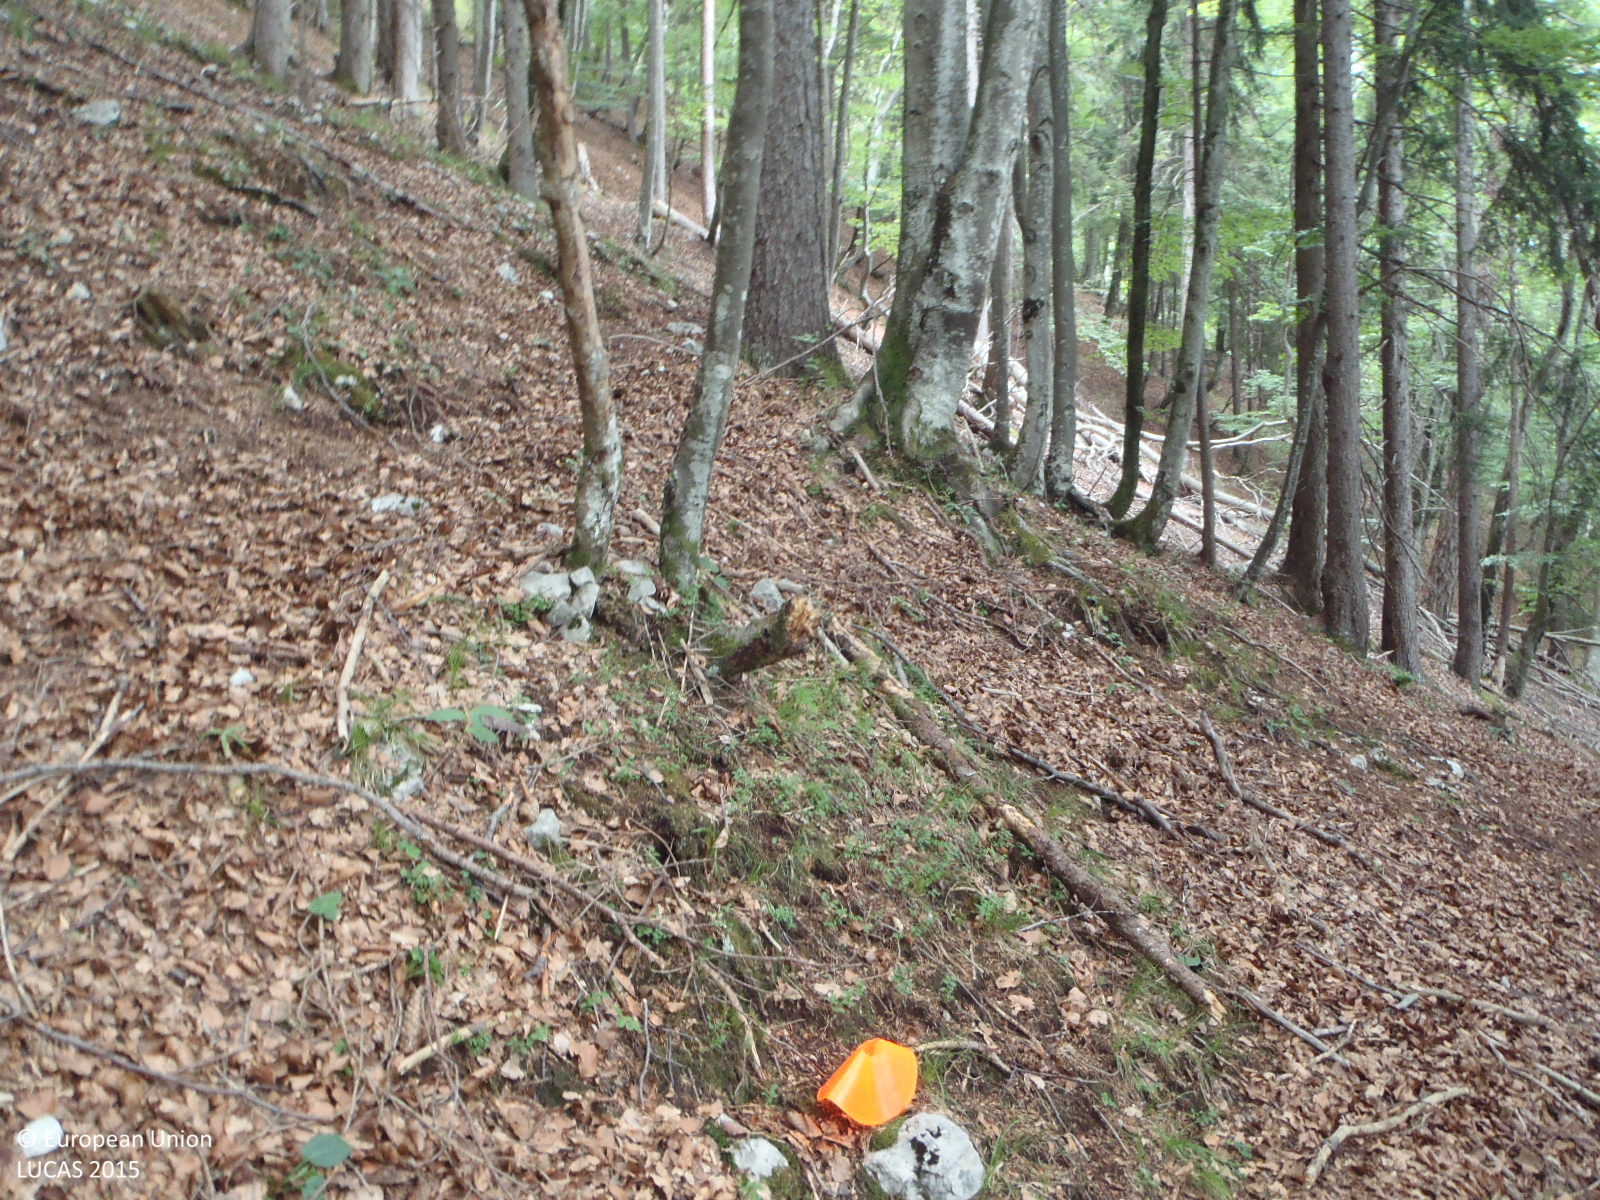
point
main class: Woodland
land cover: Spruce dominated mixed woodland
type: alpine coniferous forest
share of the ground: > 75 %
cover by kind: coniferous forest trees 45 %, broadleaved forest trees 45 %, unconsolidated bare surface 10 %
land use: Forestry
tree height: > 5 m
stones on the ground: < 10 %
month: July
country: AT
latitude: 47.4169
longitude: 11.7879
